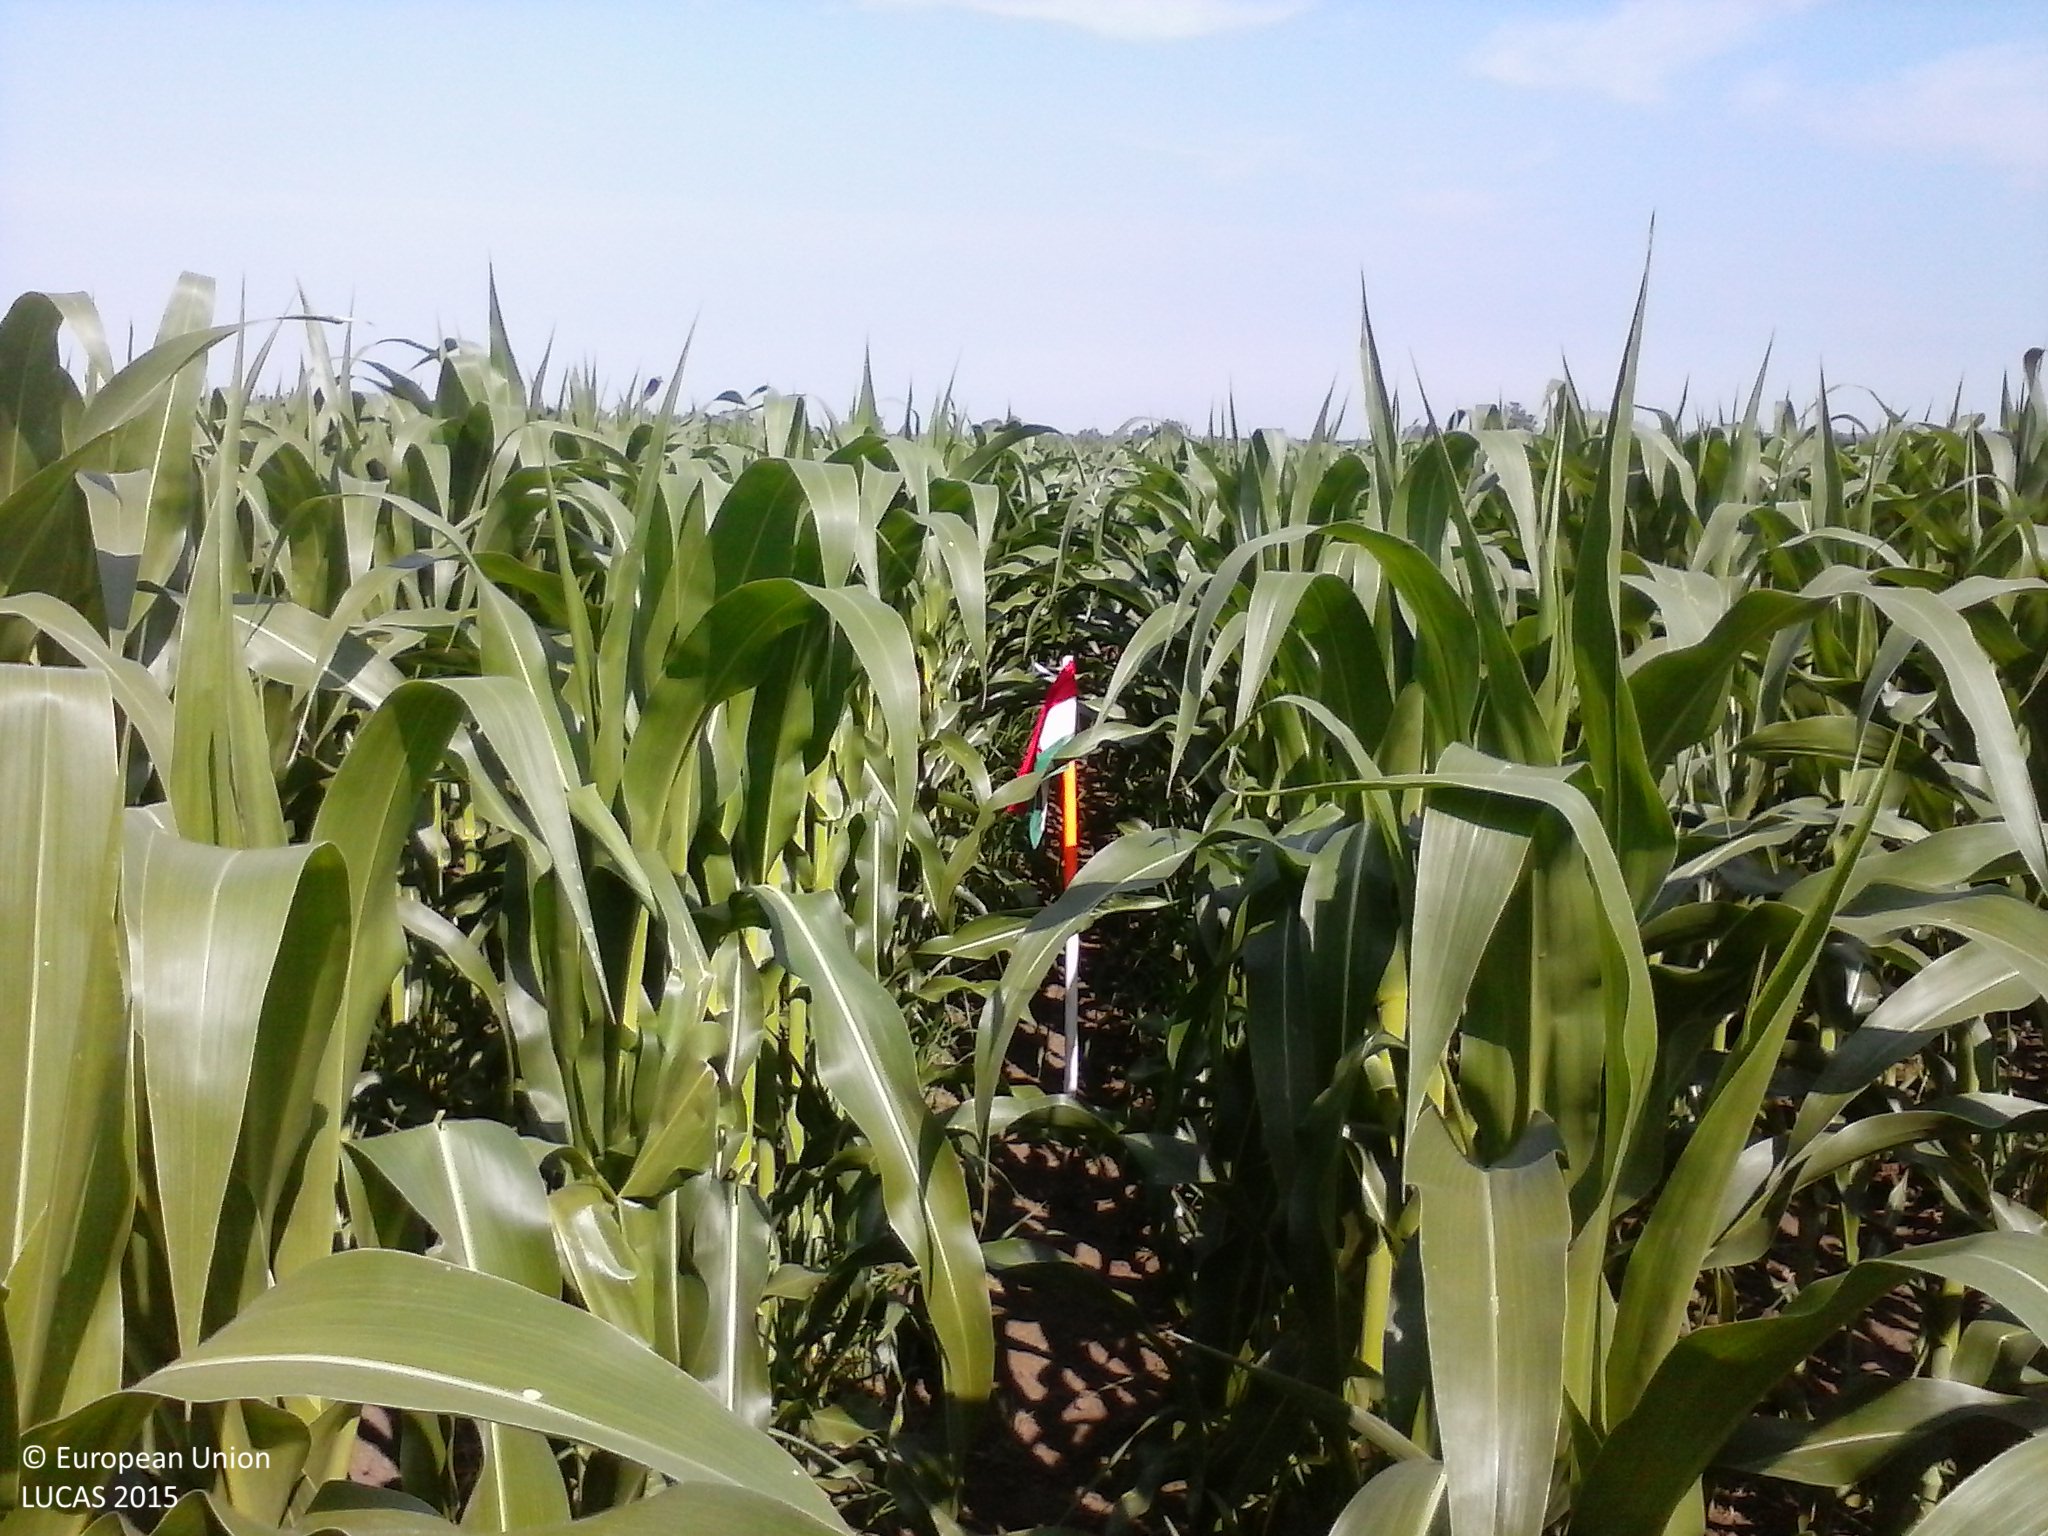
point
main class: Cropland
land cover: Maize
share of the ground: > 75 %
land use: Agriculture (excluding fallow land and kitchen gardens)
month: June
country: HU
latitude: 46.1624
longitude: 19.5087
